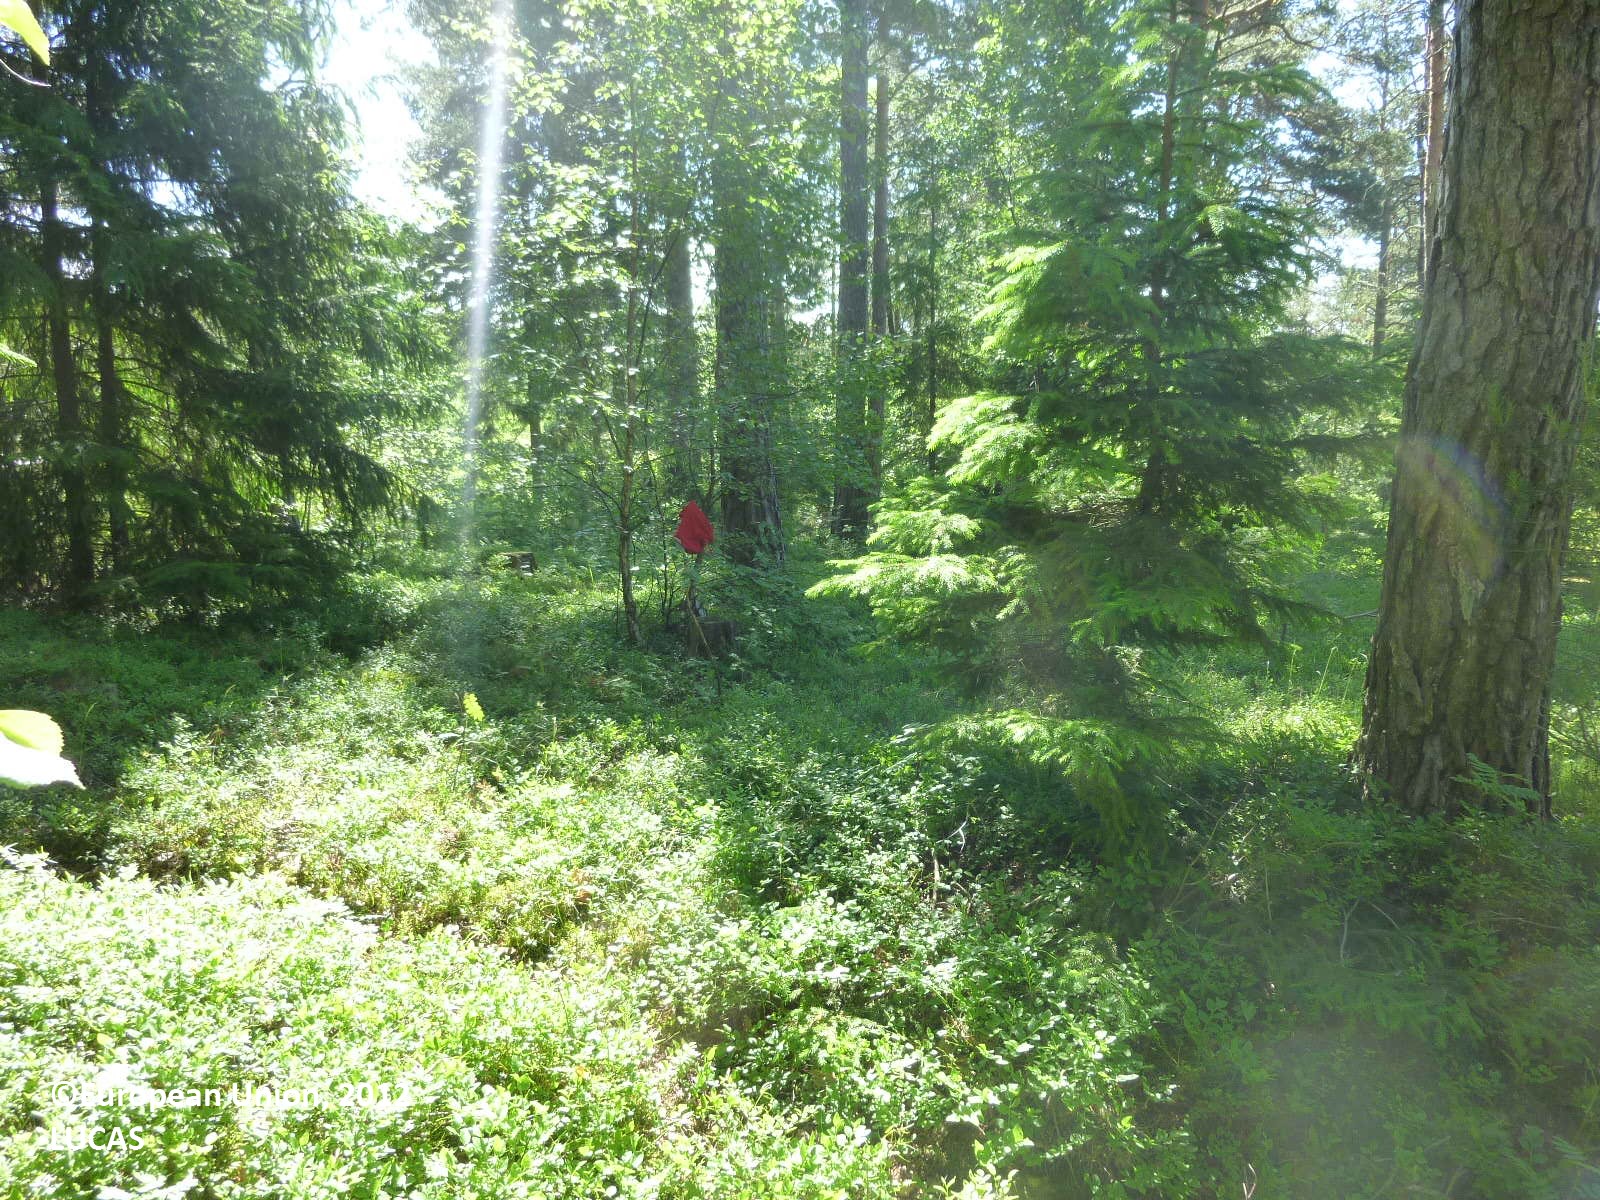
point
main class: Woodland
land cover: Other coniferous woodland
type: boreal forest
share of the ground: 25 - 50 %
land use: Forestry
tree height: > 5 m
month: June
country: FI
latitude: 60.2091
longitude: 22.4679
